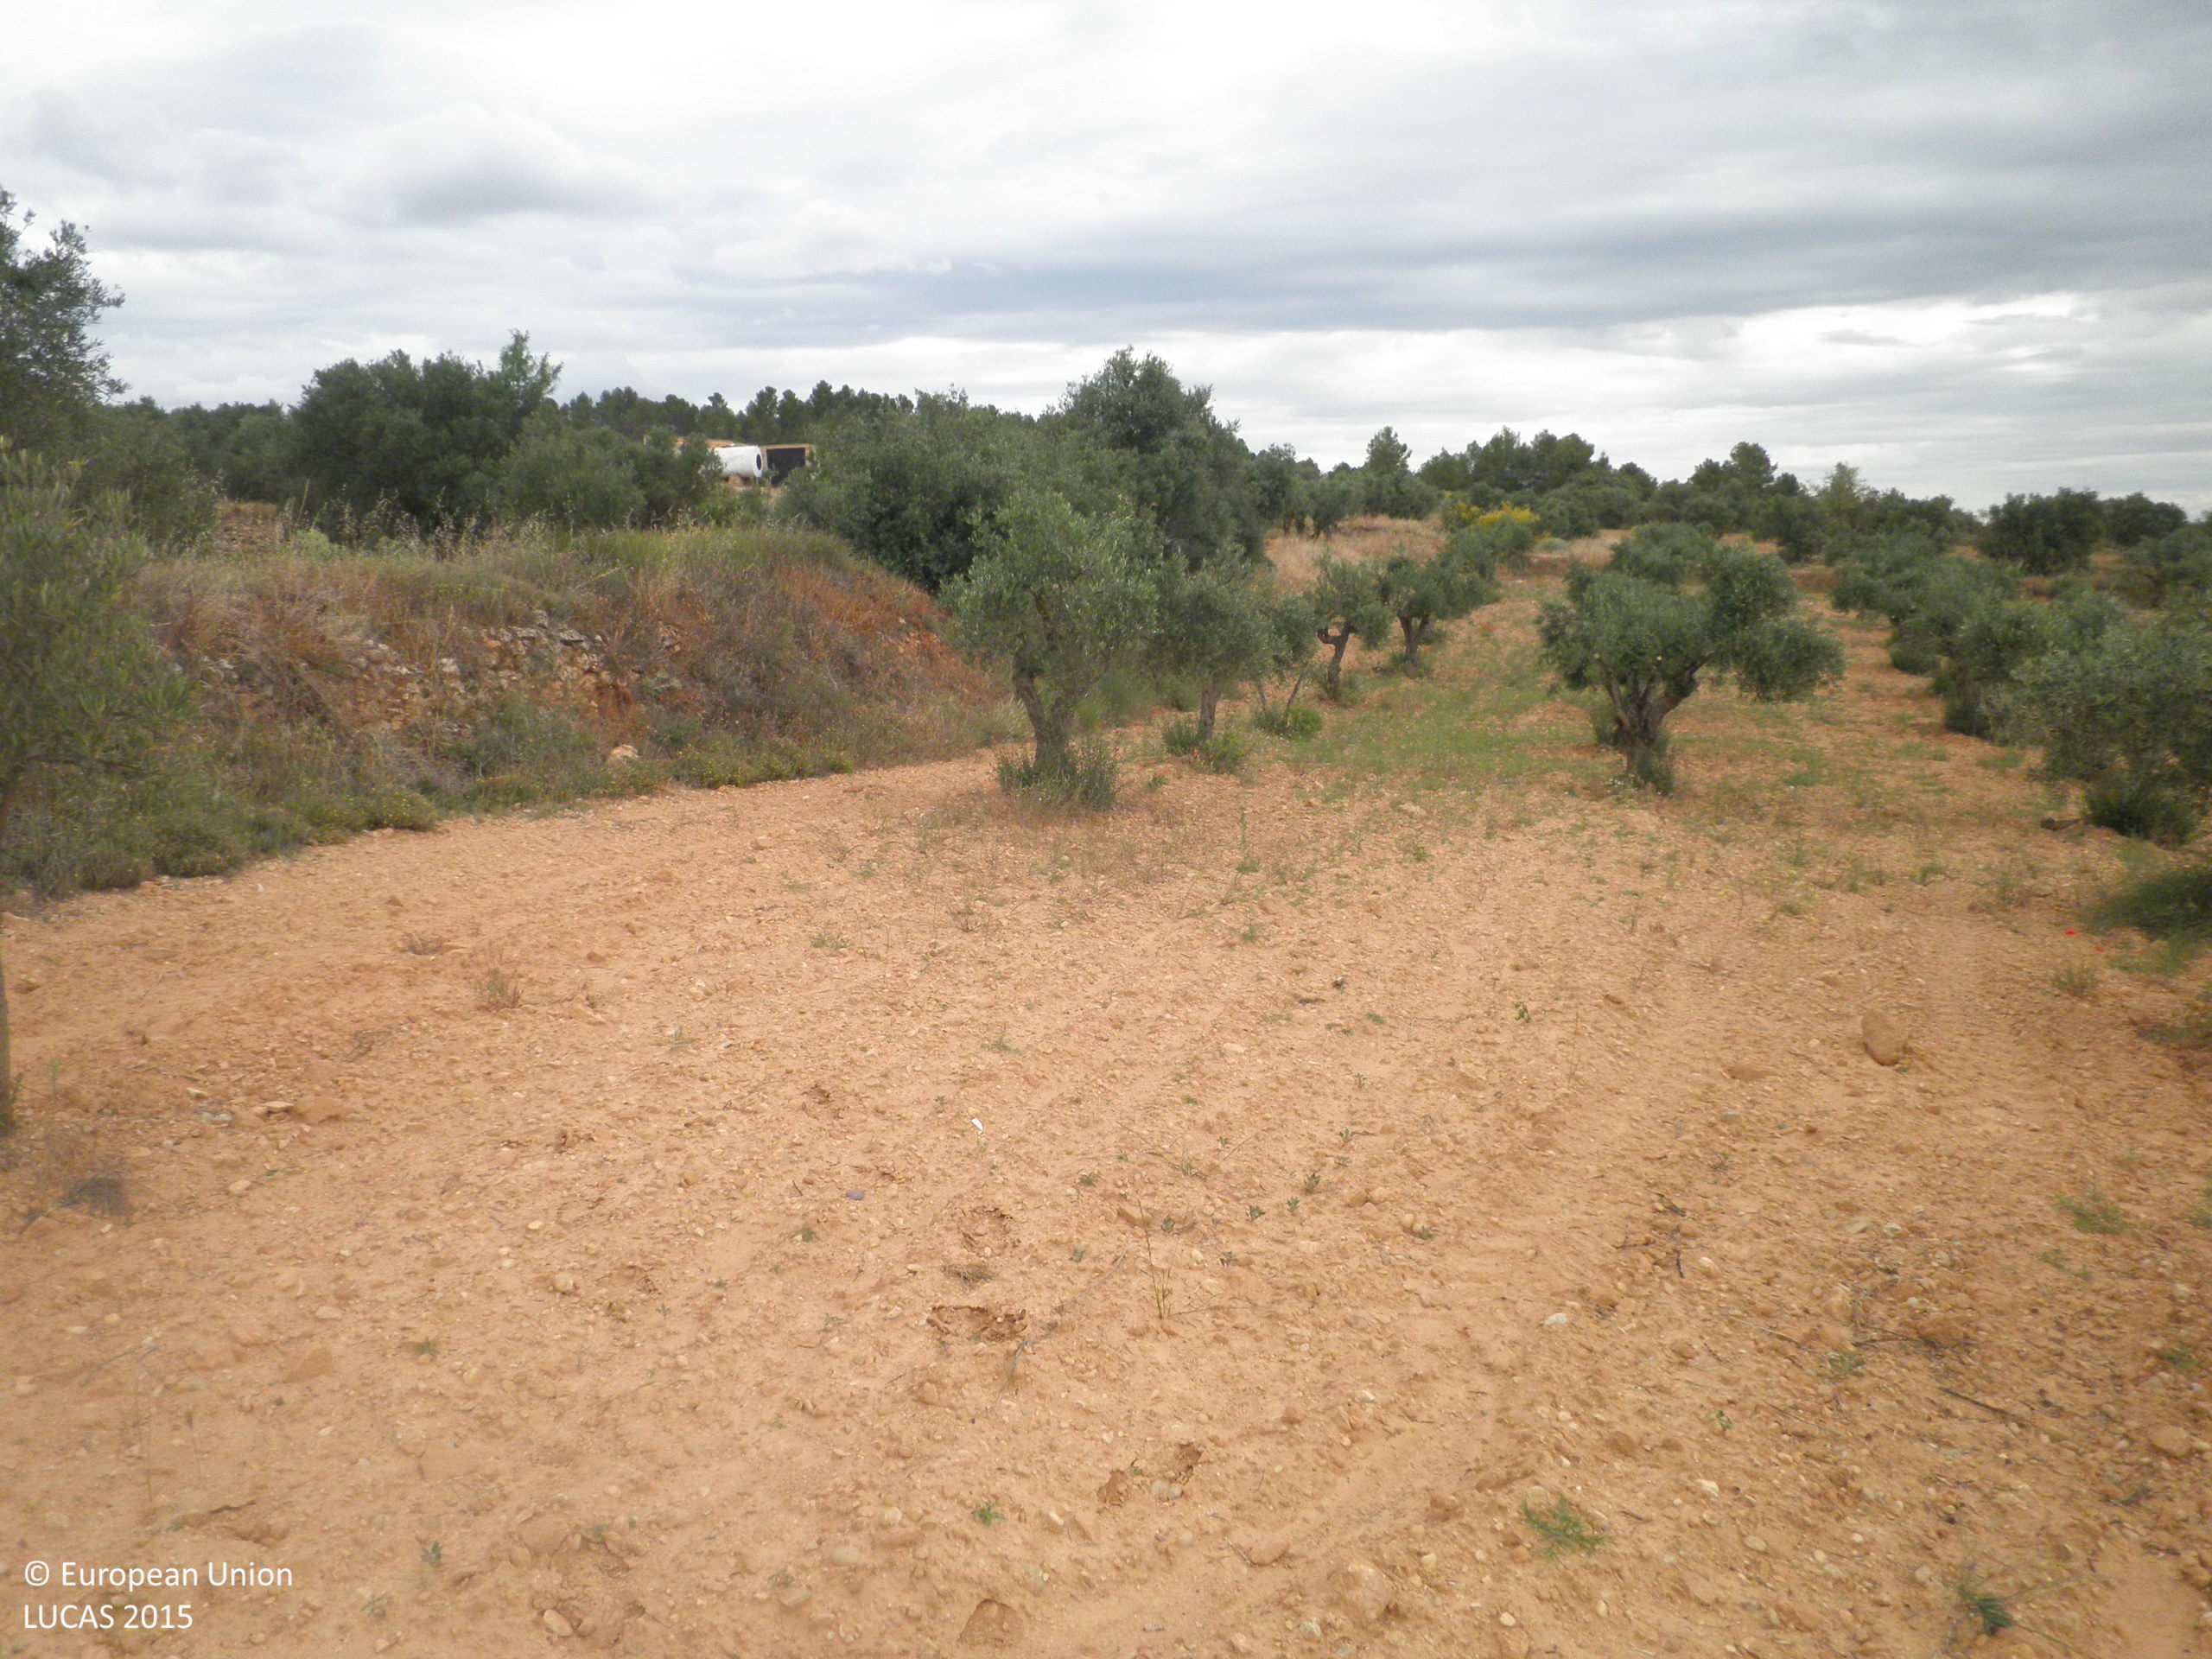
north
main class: Cropland
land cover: Olive groves
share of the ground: < 10 %
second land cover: Spontaneously vegetated surfaces
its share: > 75 %
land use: Agriculture (excluding fallow land and kitchen gardens)
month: June
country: ES
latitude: 39.5781
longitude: -1.5893
